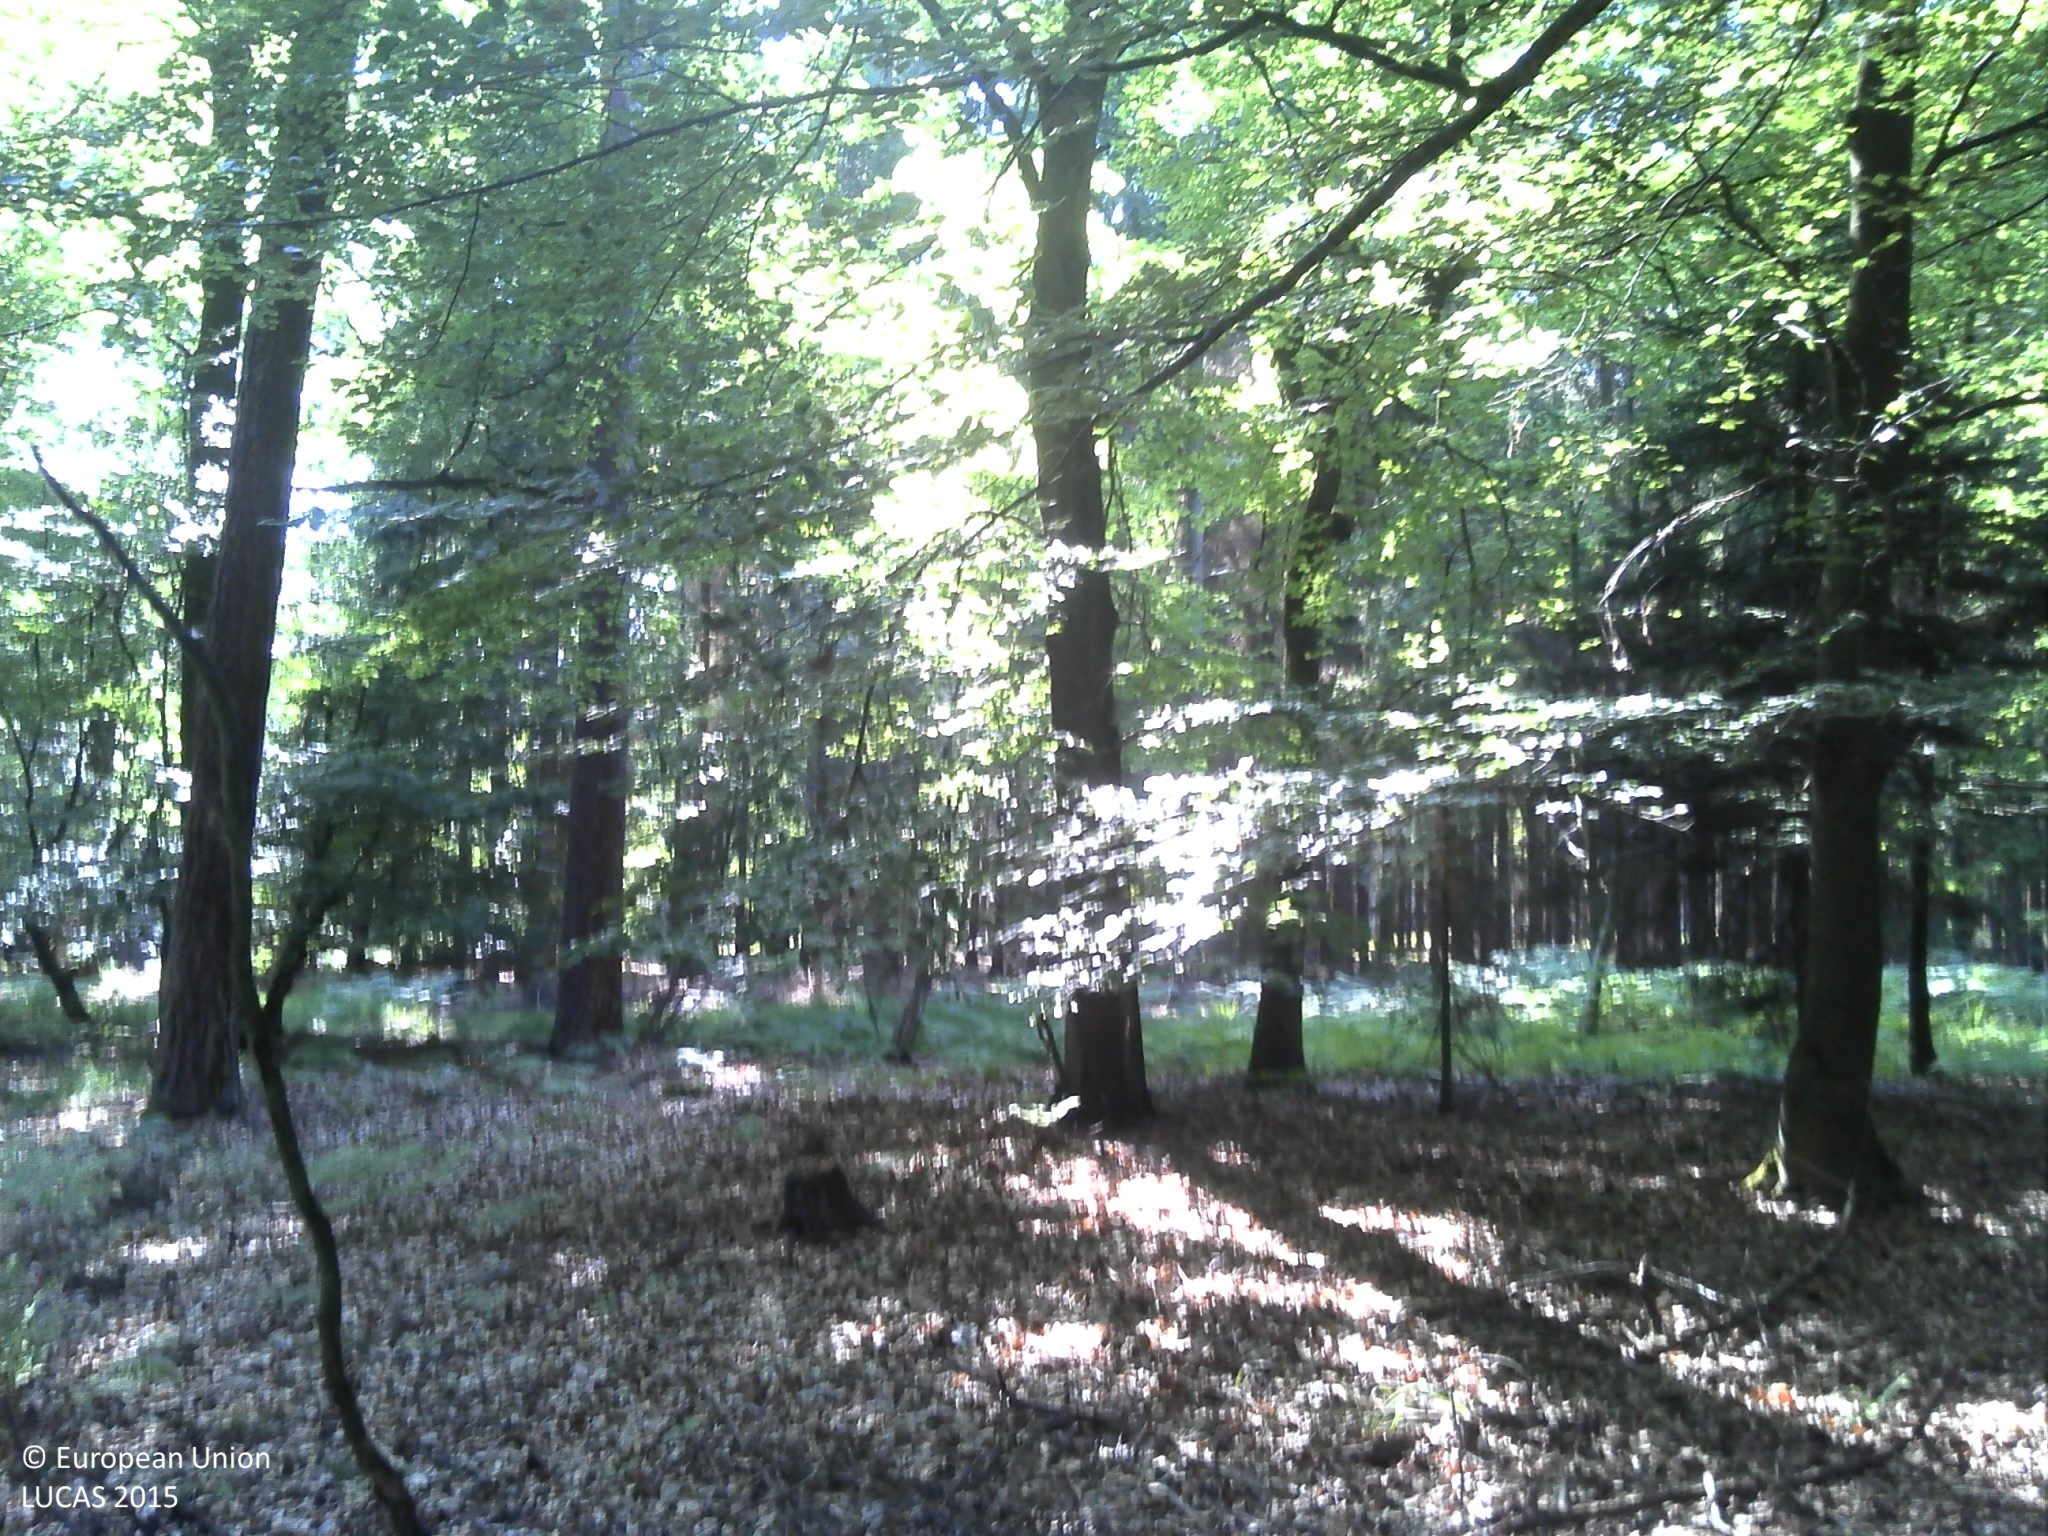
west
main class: Woodland
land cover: Pine dominated mixed woodland
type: acidophilous oak and oak-birch forest
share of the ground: > 75 %
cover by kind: coniferous forest trees 50 %, broadleaved forest trees 50 %
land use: Forestry
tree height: > 5 m
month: July
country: FR
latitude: 49.1480
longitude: 6.7510
